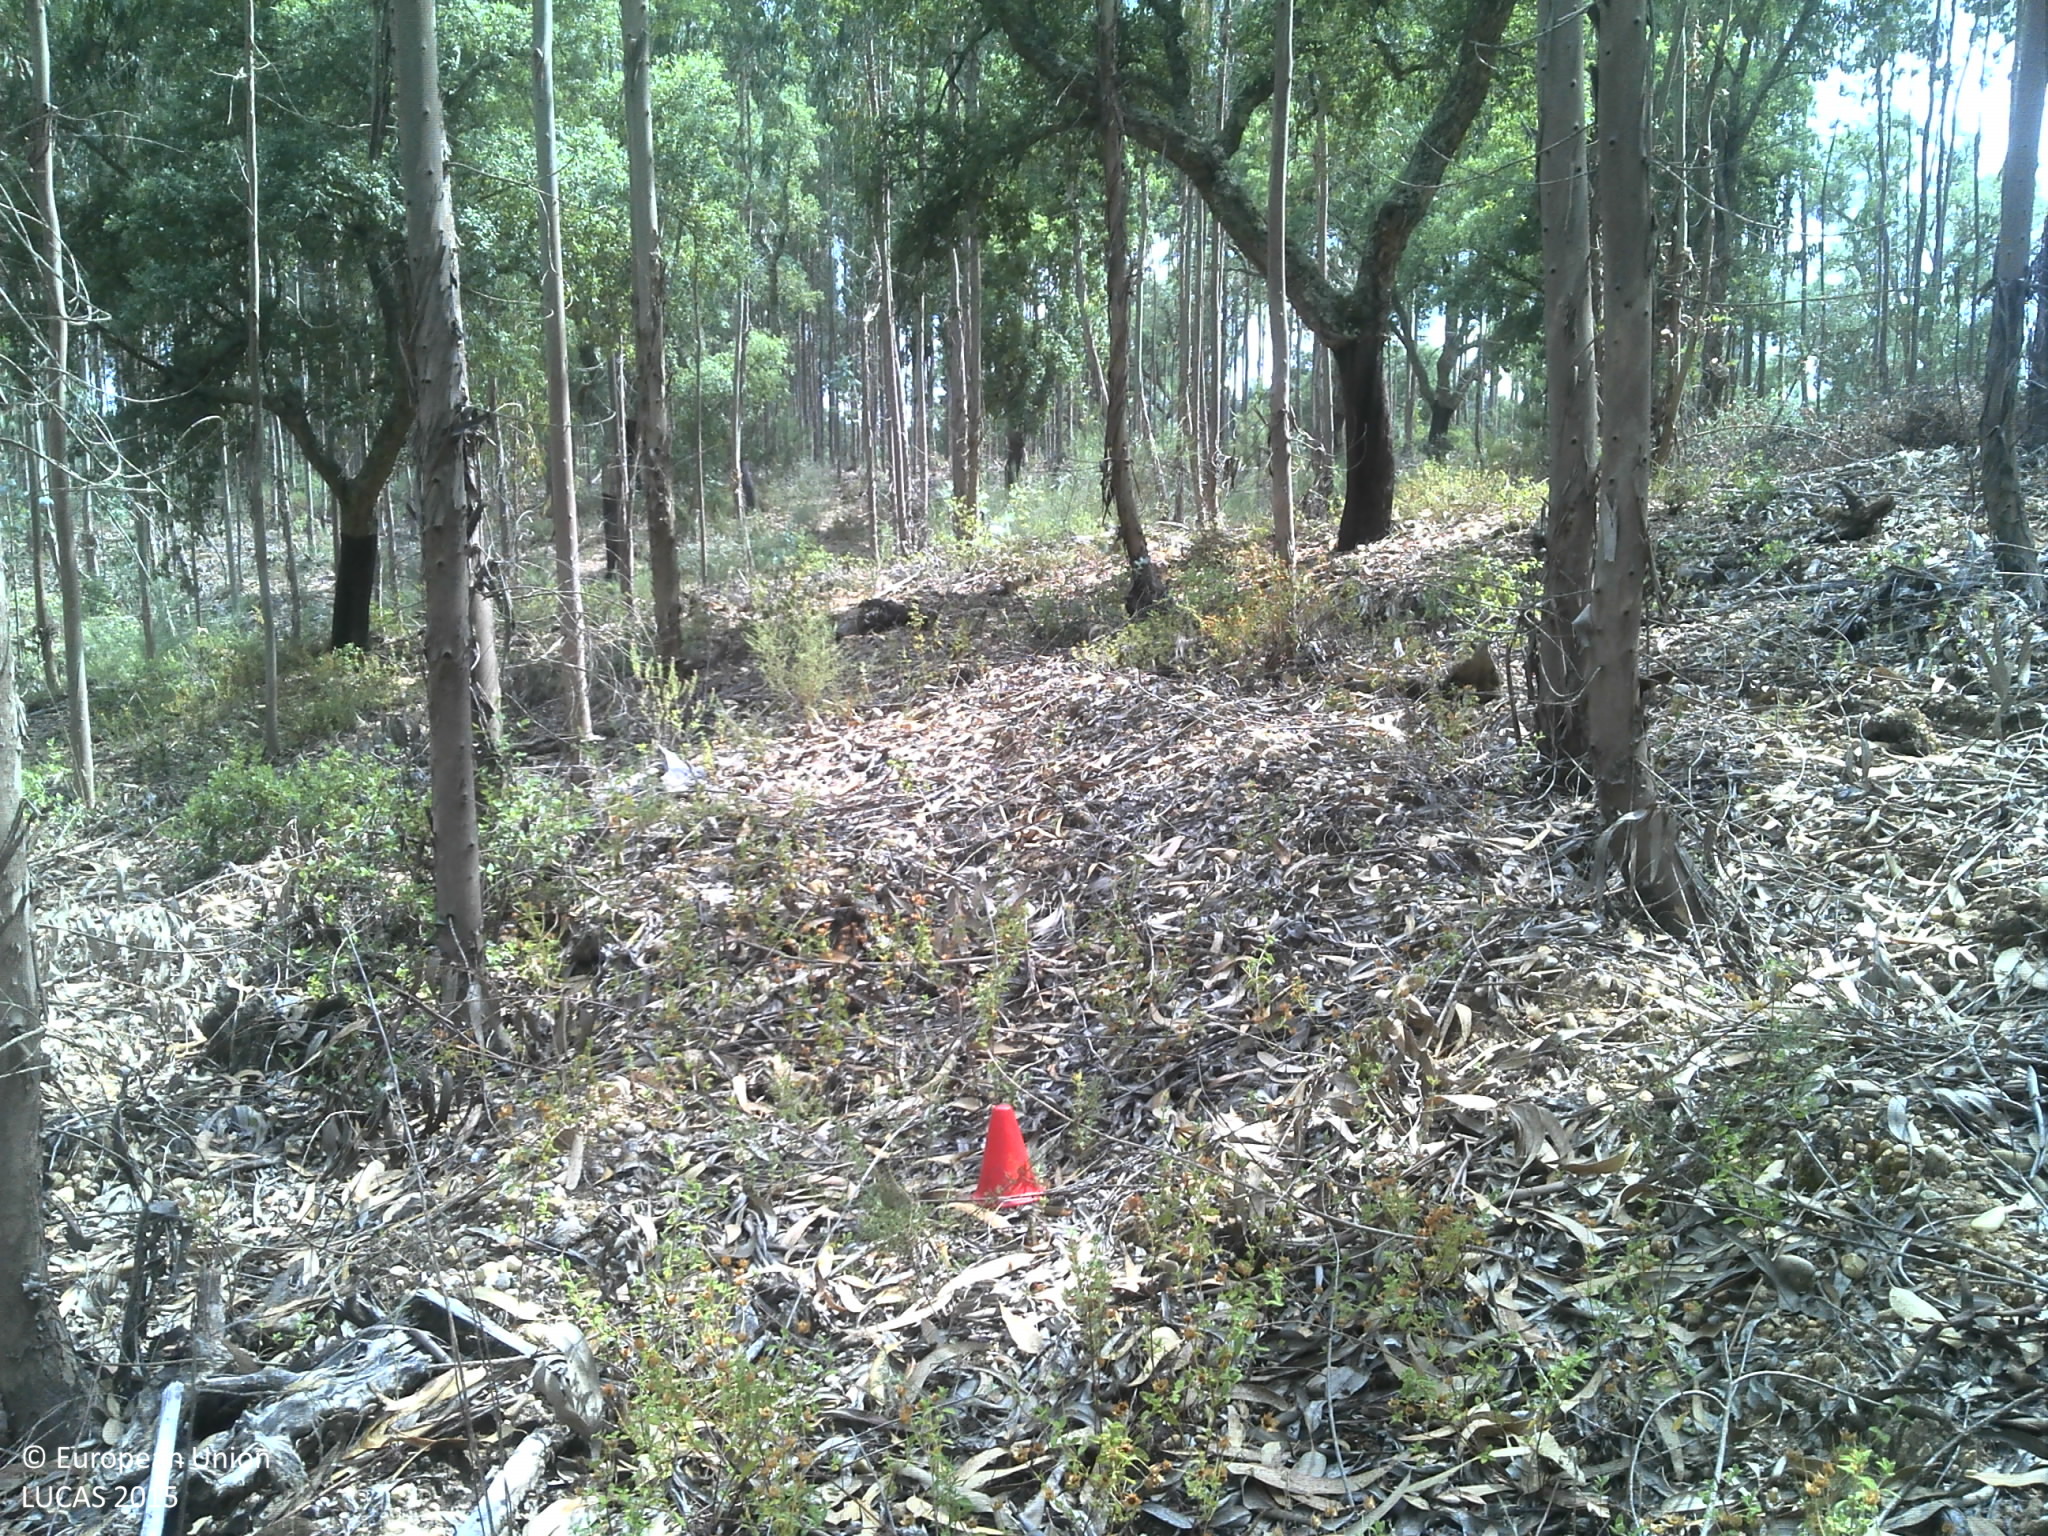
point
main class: Woodland
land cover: Broadleaved woodland
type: exotic forest
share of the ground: 25 - 50 %
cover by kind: broadleaved forest trees 50 %, unconsolidated bare surface 40 %, herbaceous plants 10 %
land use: Forestry
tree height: > 5 m
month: June
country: PT
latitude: 39.2747
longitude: -8.3679
